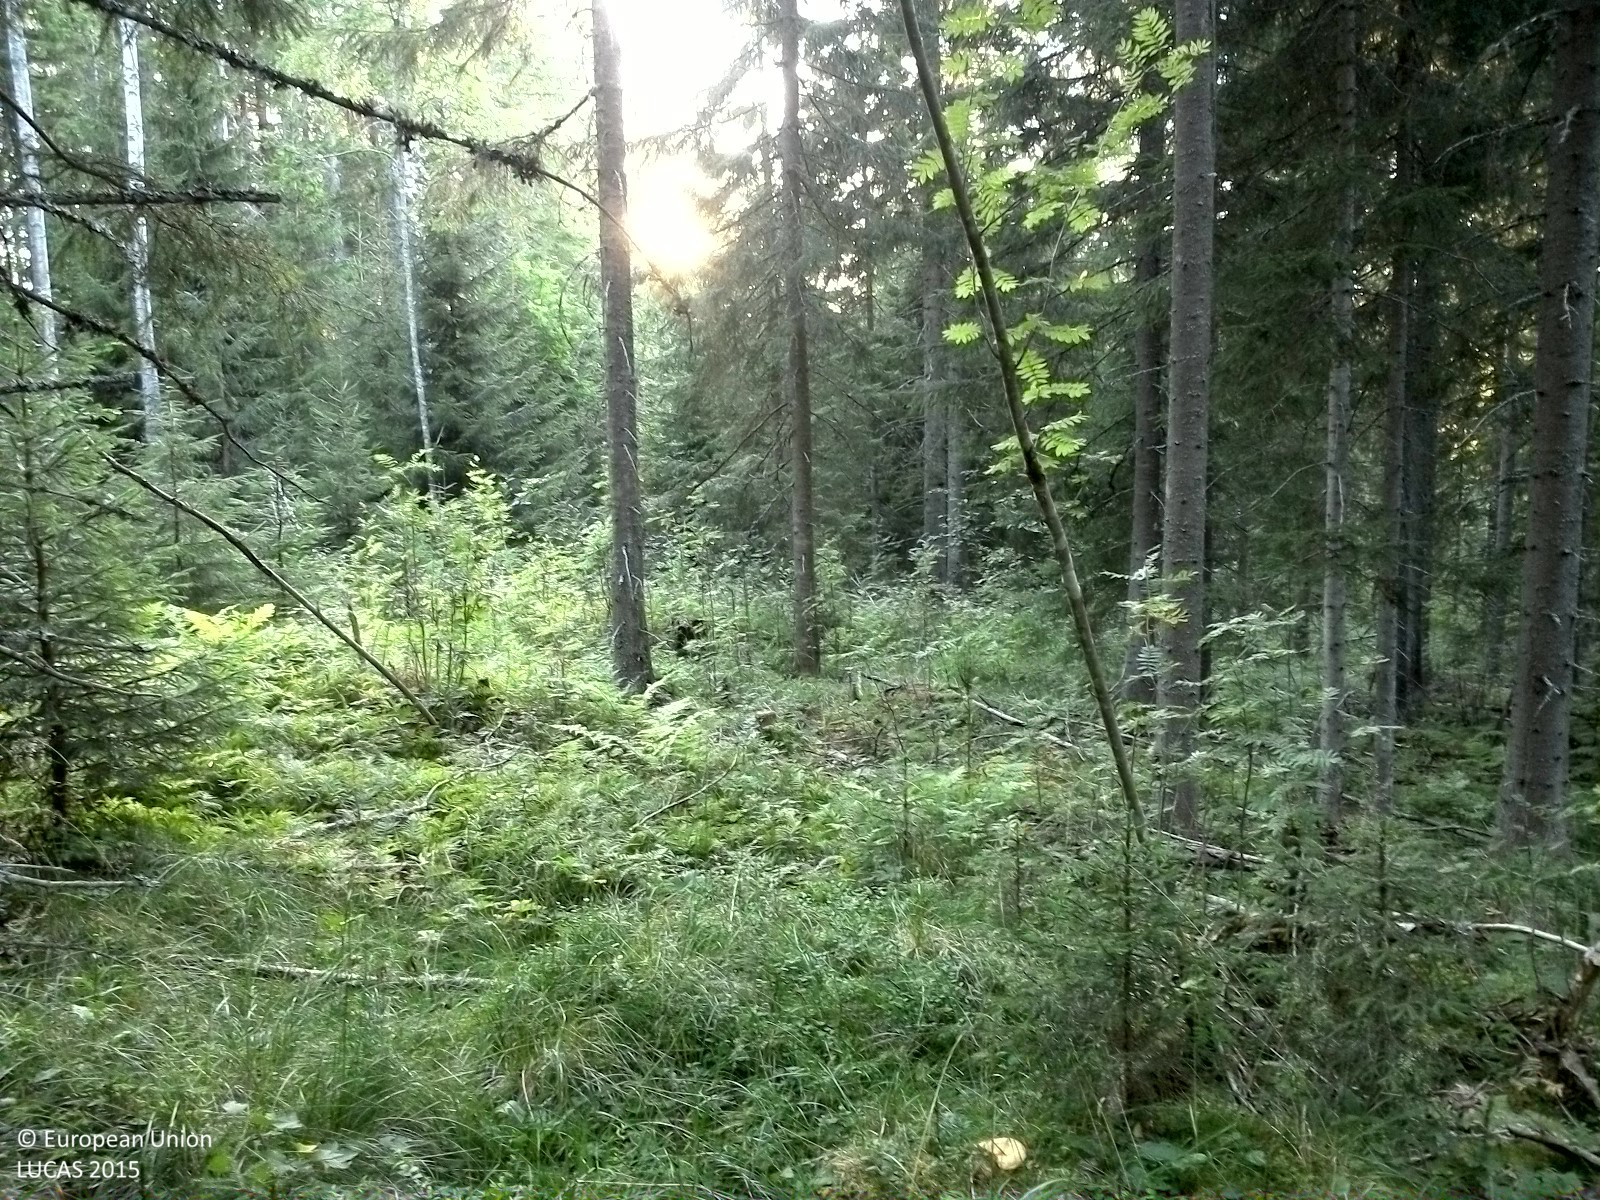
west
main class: Woodland
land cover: Spruce dominated mixed woodland
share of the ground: 25 - 50 %
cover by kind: herbaceous plants 50 %, coniferous forest trees 35 %, broadleaved forest trees 15 %
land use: Forestry
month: August
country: SE
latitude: 62.3108
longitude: 16.8671
